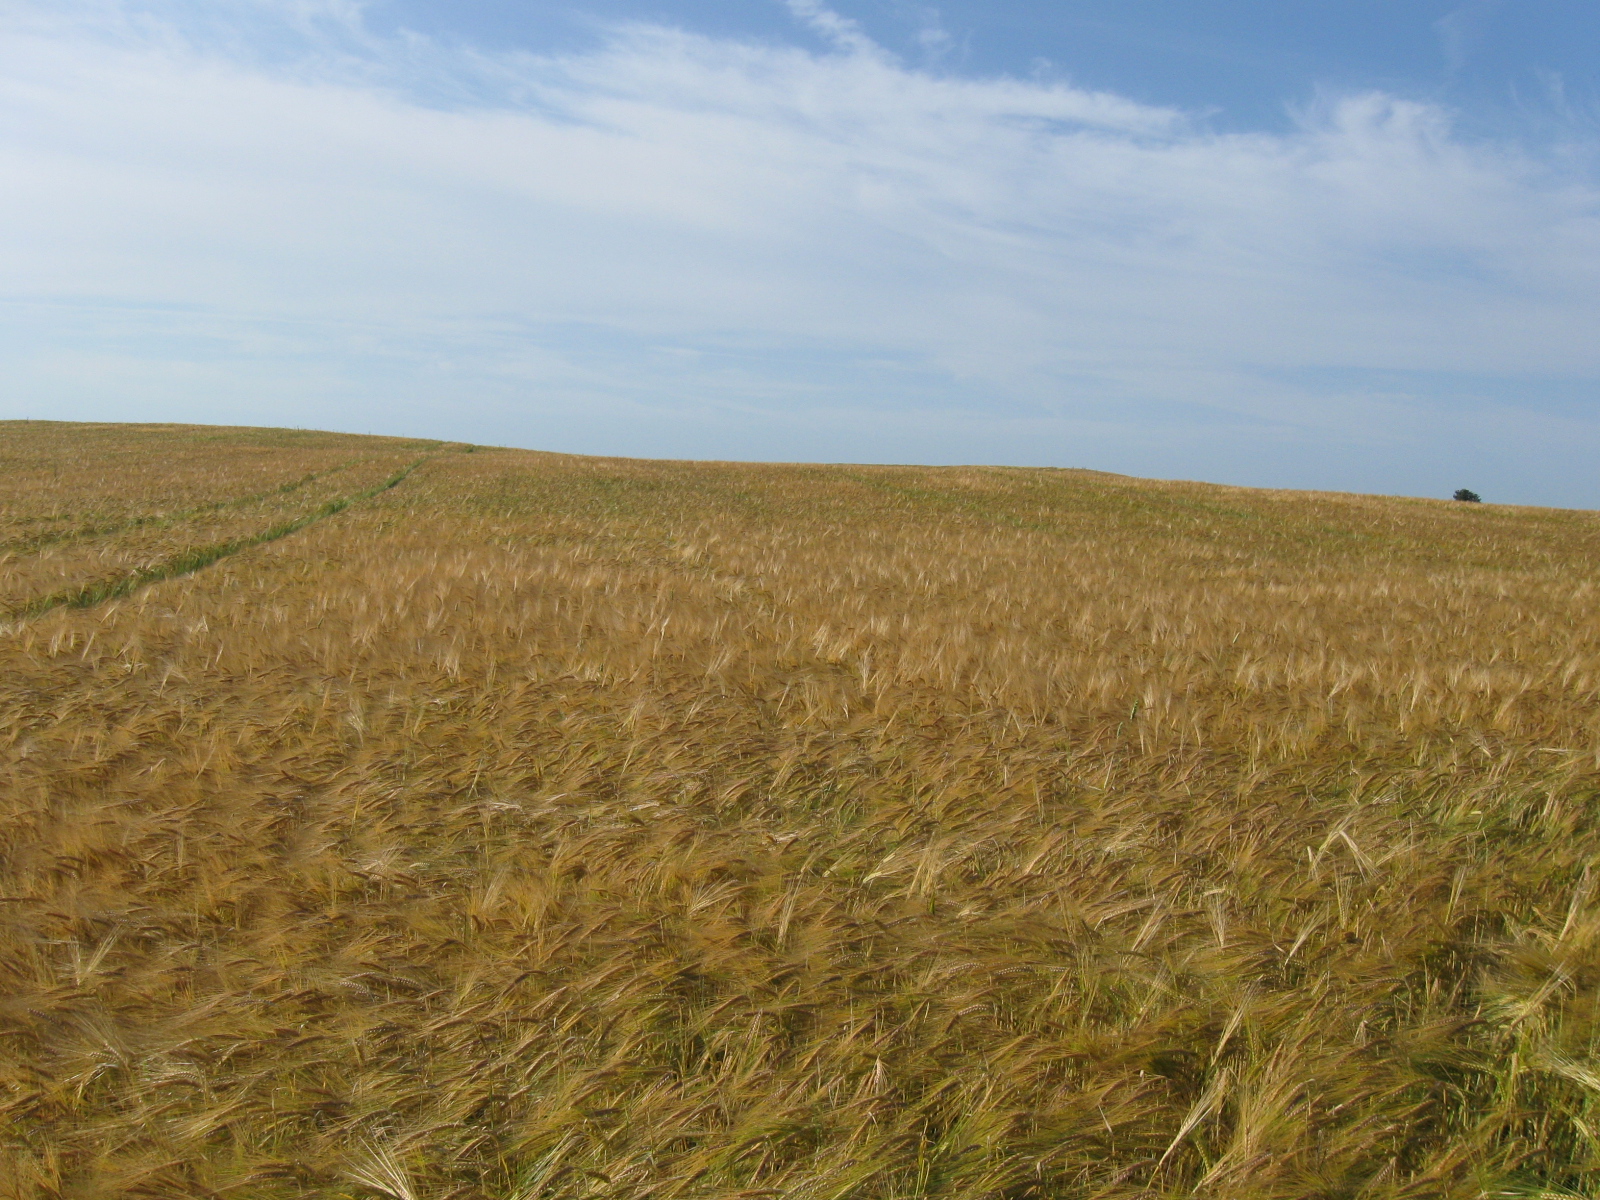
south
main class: Cropland
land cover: Barley
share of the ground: > 75 %
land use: Agriculture (excluding fallow land and kitchen gardens)
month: July
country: LT
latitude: 54.4880
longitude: 23.4650
